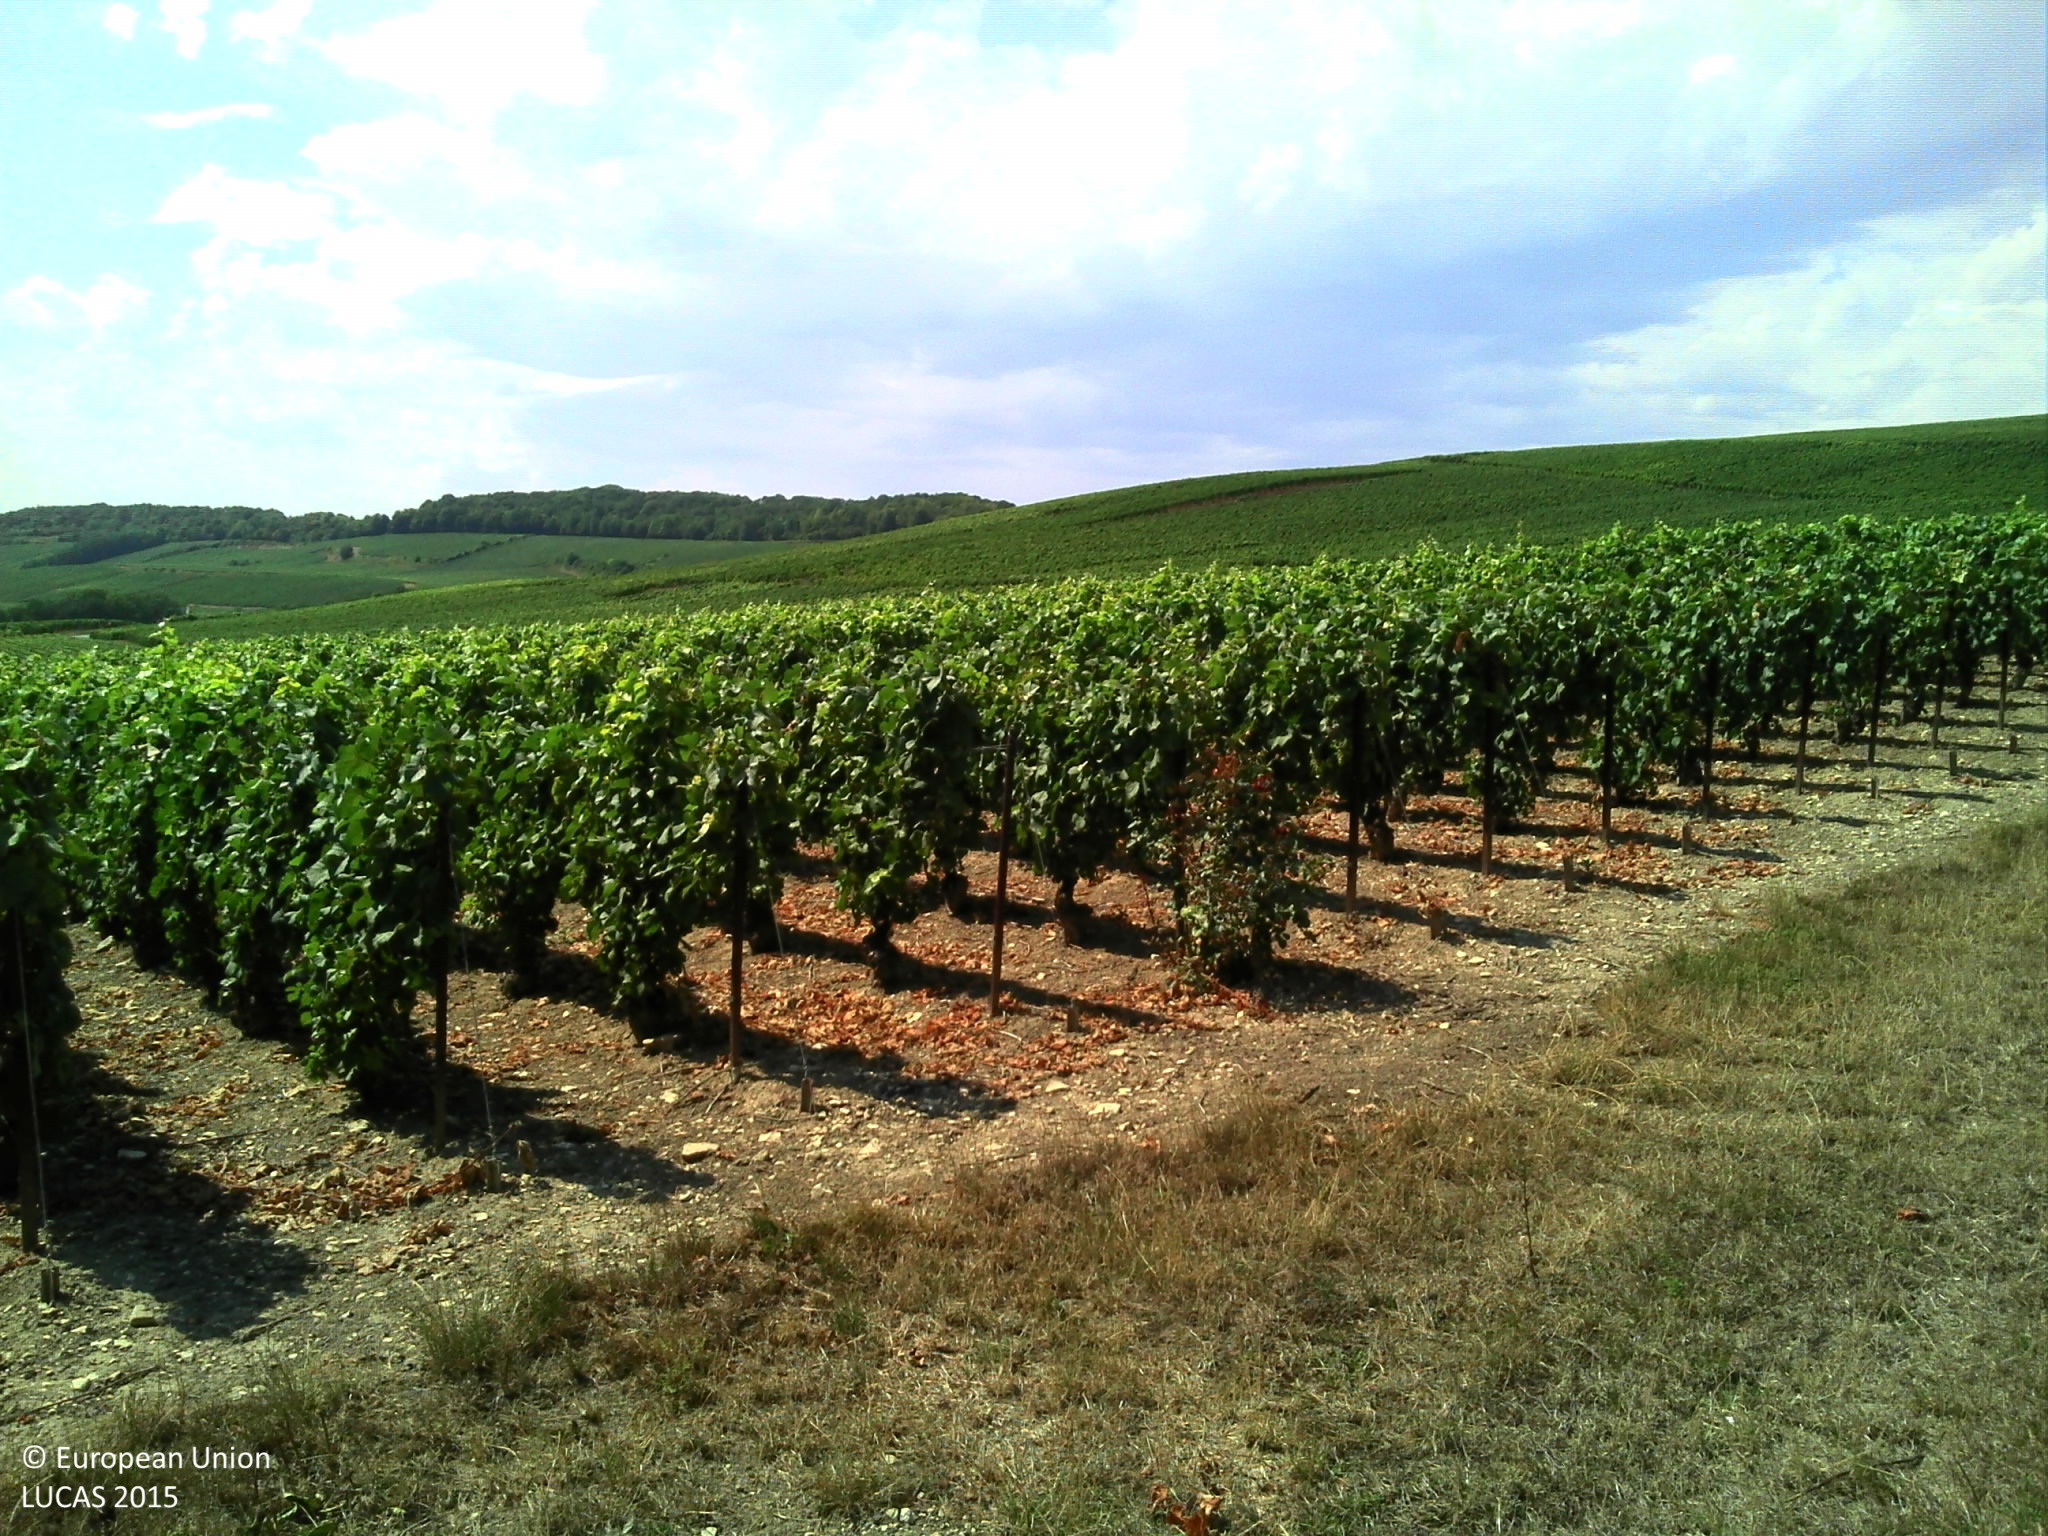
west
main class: Grassland
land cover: Grassland without tree/shrub cover
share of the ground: > 75 %
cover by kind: herbaceous plants 85 %, consolidated bare surface 5 %, unconsolidated bare surface 5 %
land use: Semi-natural and natural areas not in use
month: August
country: FR
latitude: 49.1099
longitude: 3.7336
